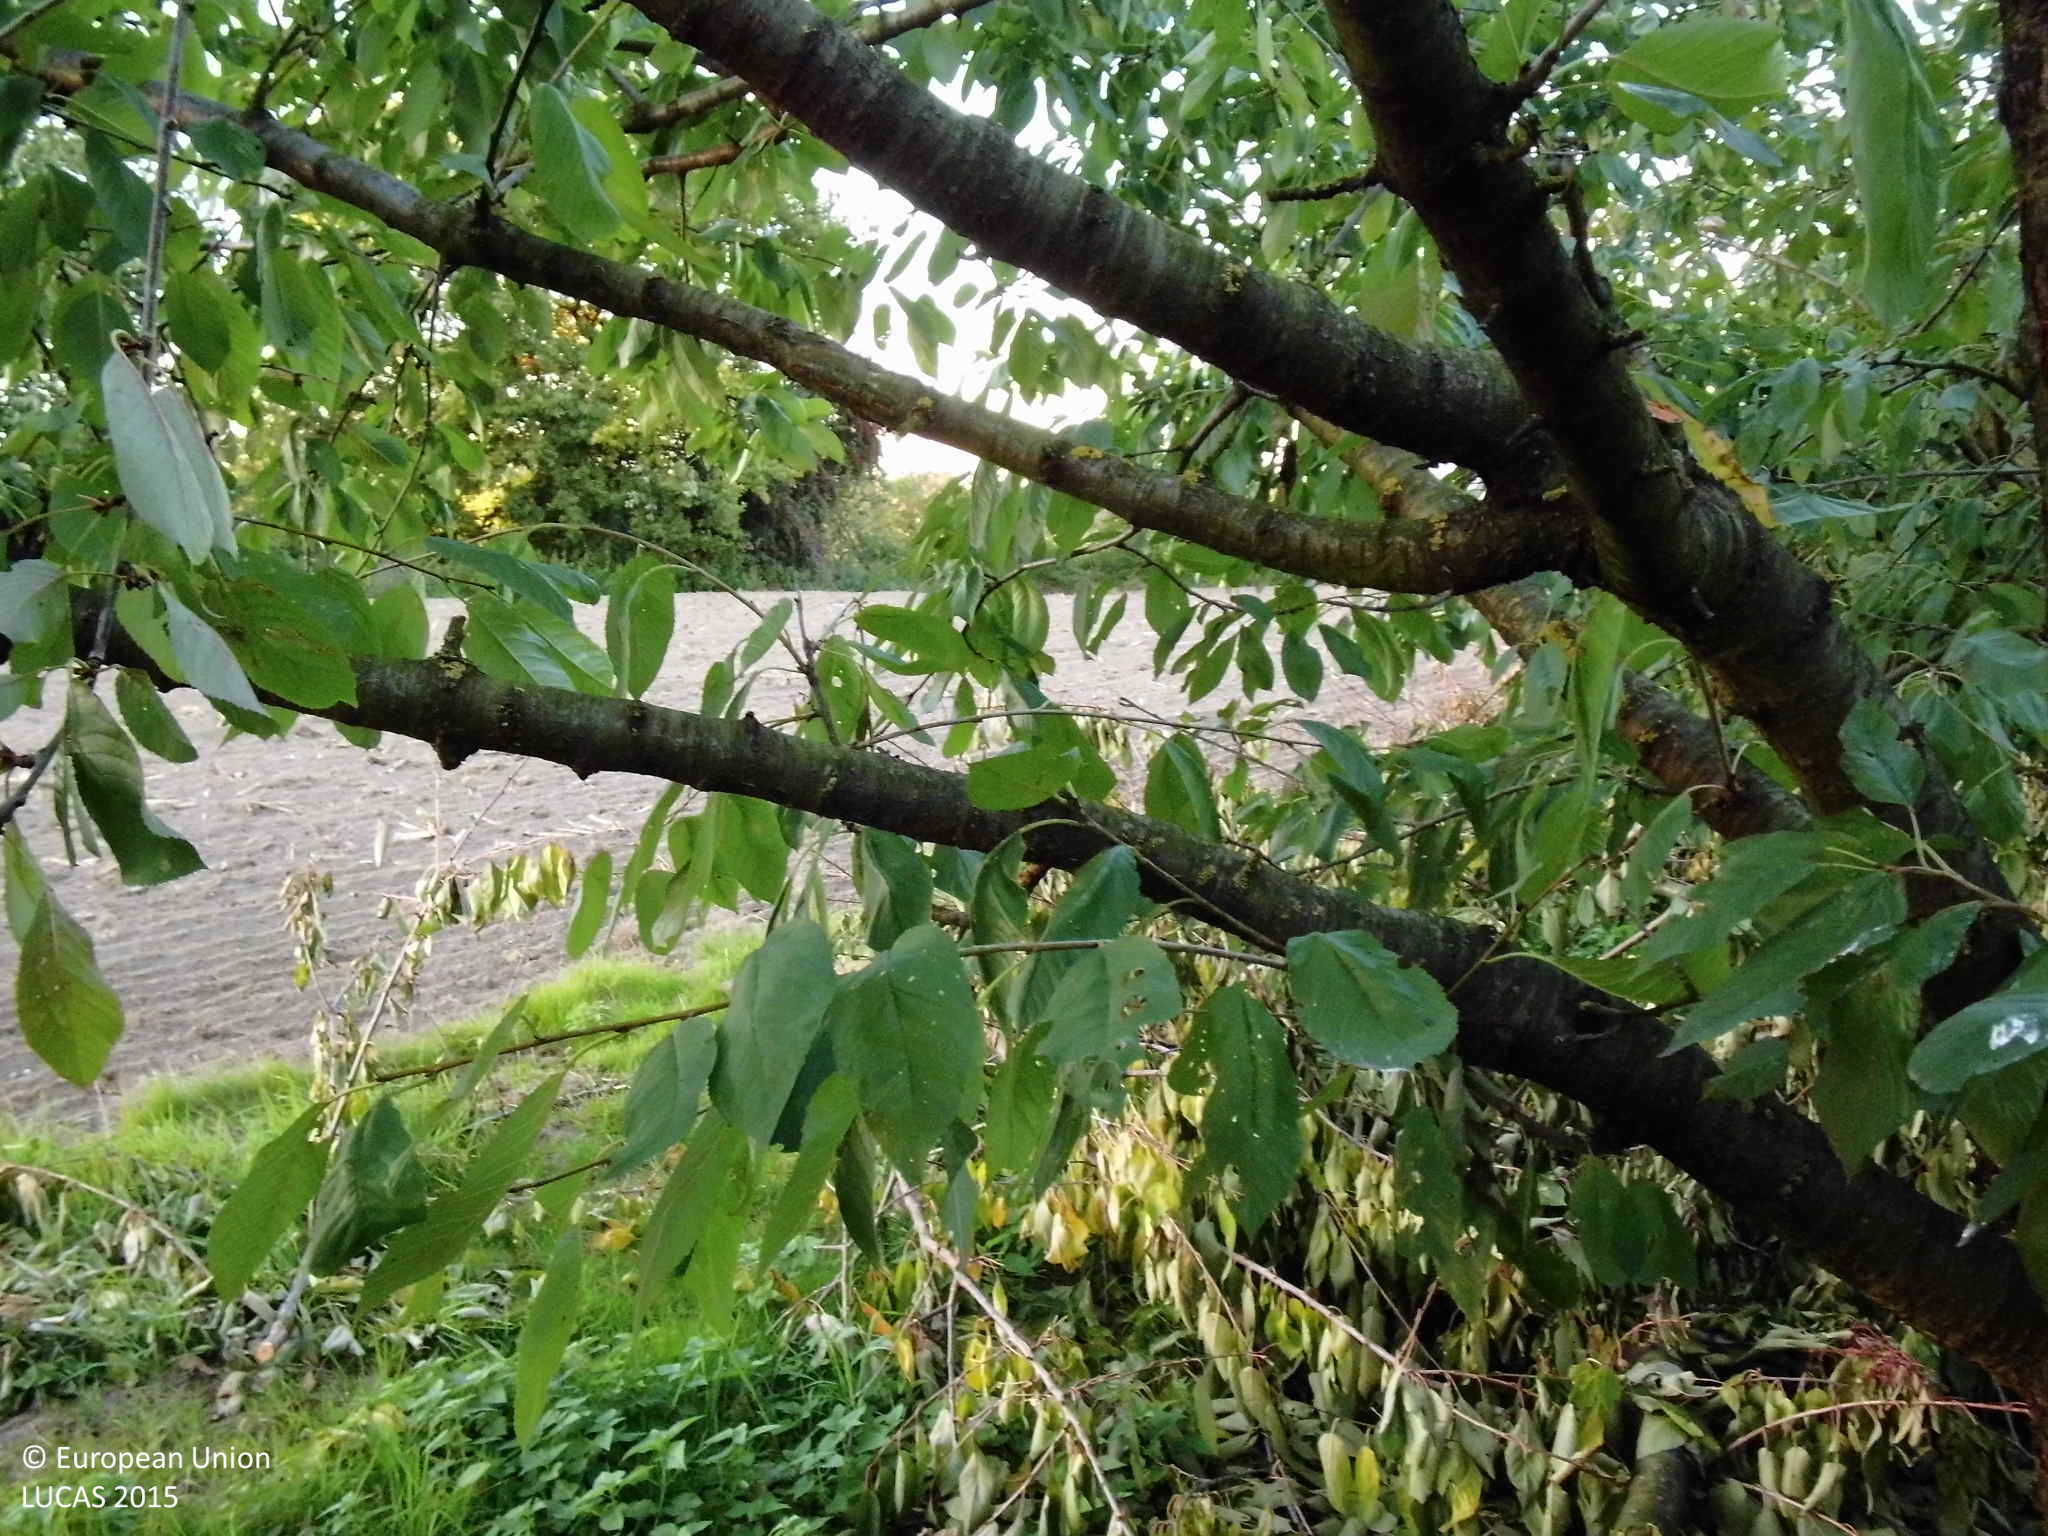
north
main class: Cropland
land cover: Cherry fruit
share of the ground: > 75 %
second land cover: Grassland without tree/shrub cover
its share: > 75 %
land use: Agriculture (excluding fallow land and kitchen gardens)
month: September
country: DE
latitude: 50.3897
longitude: 7.4544
